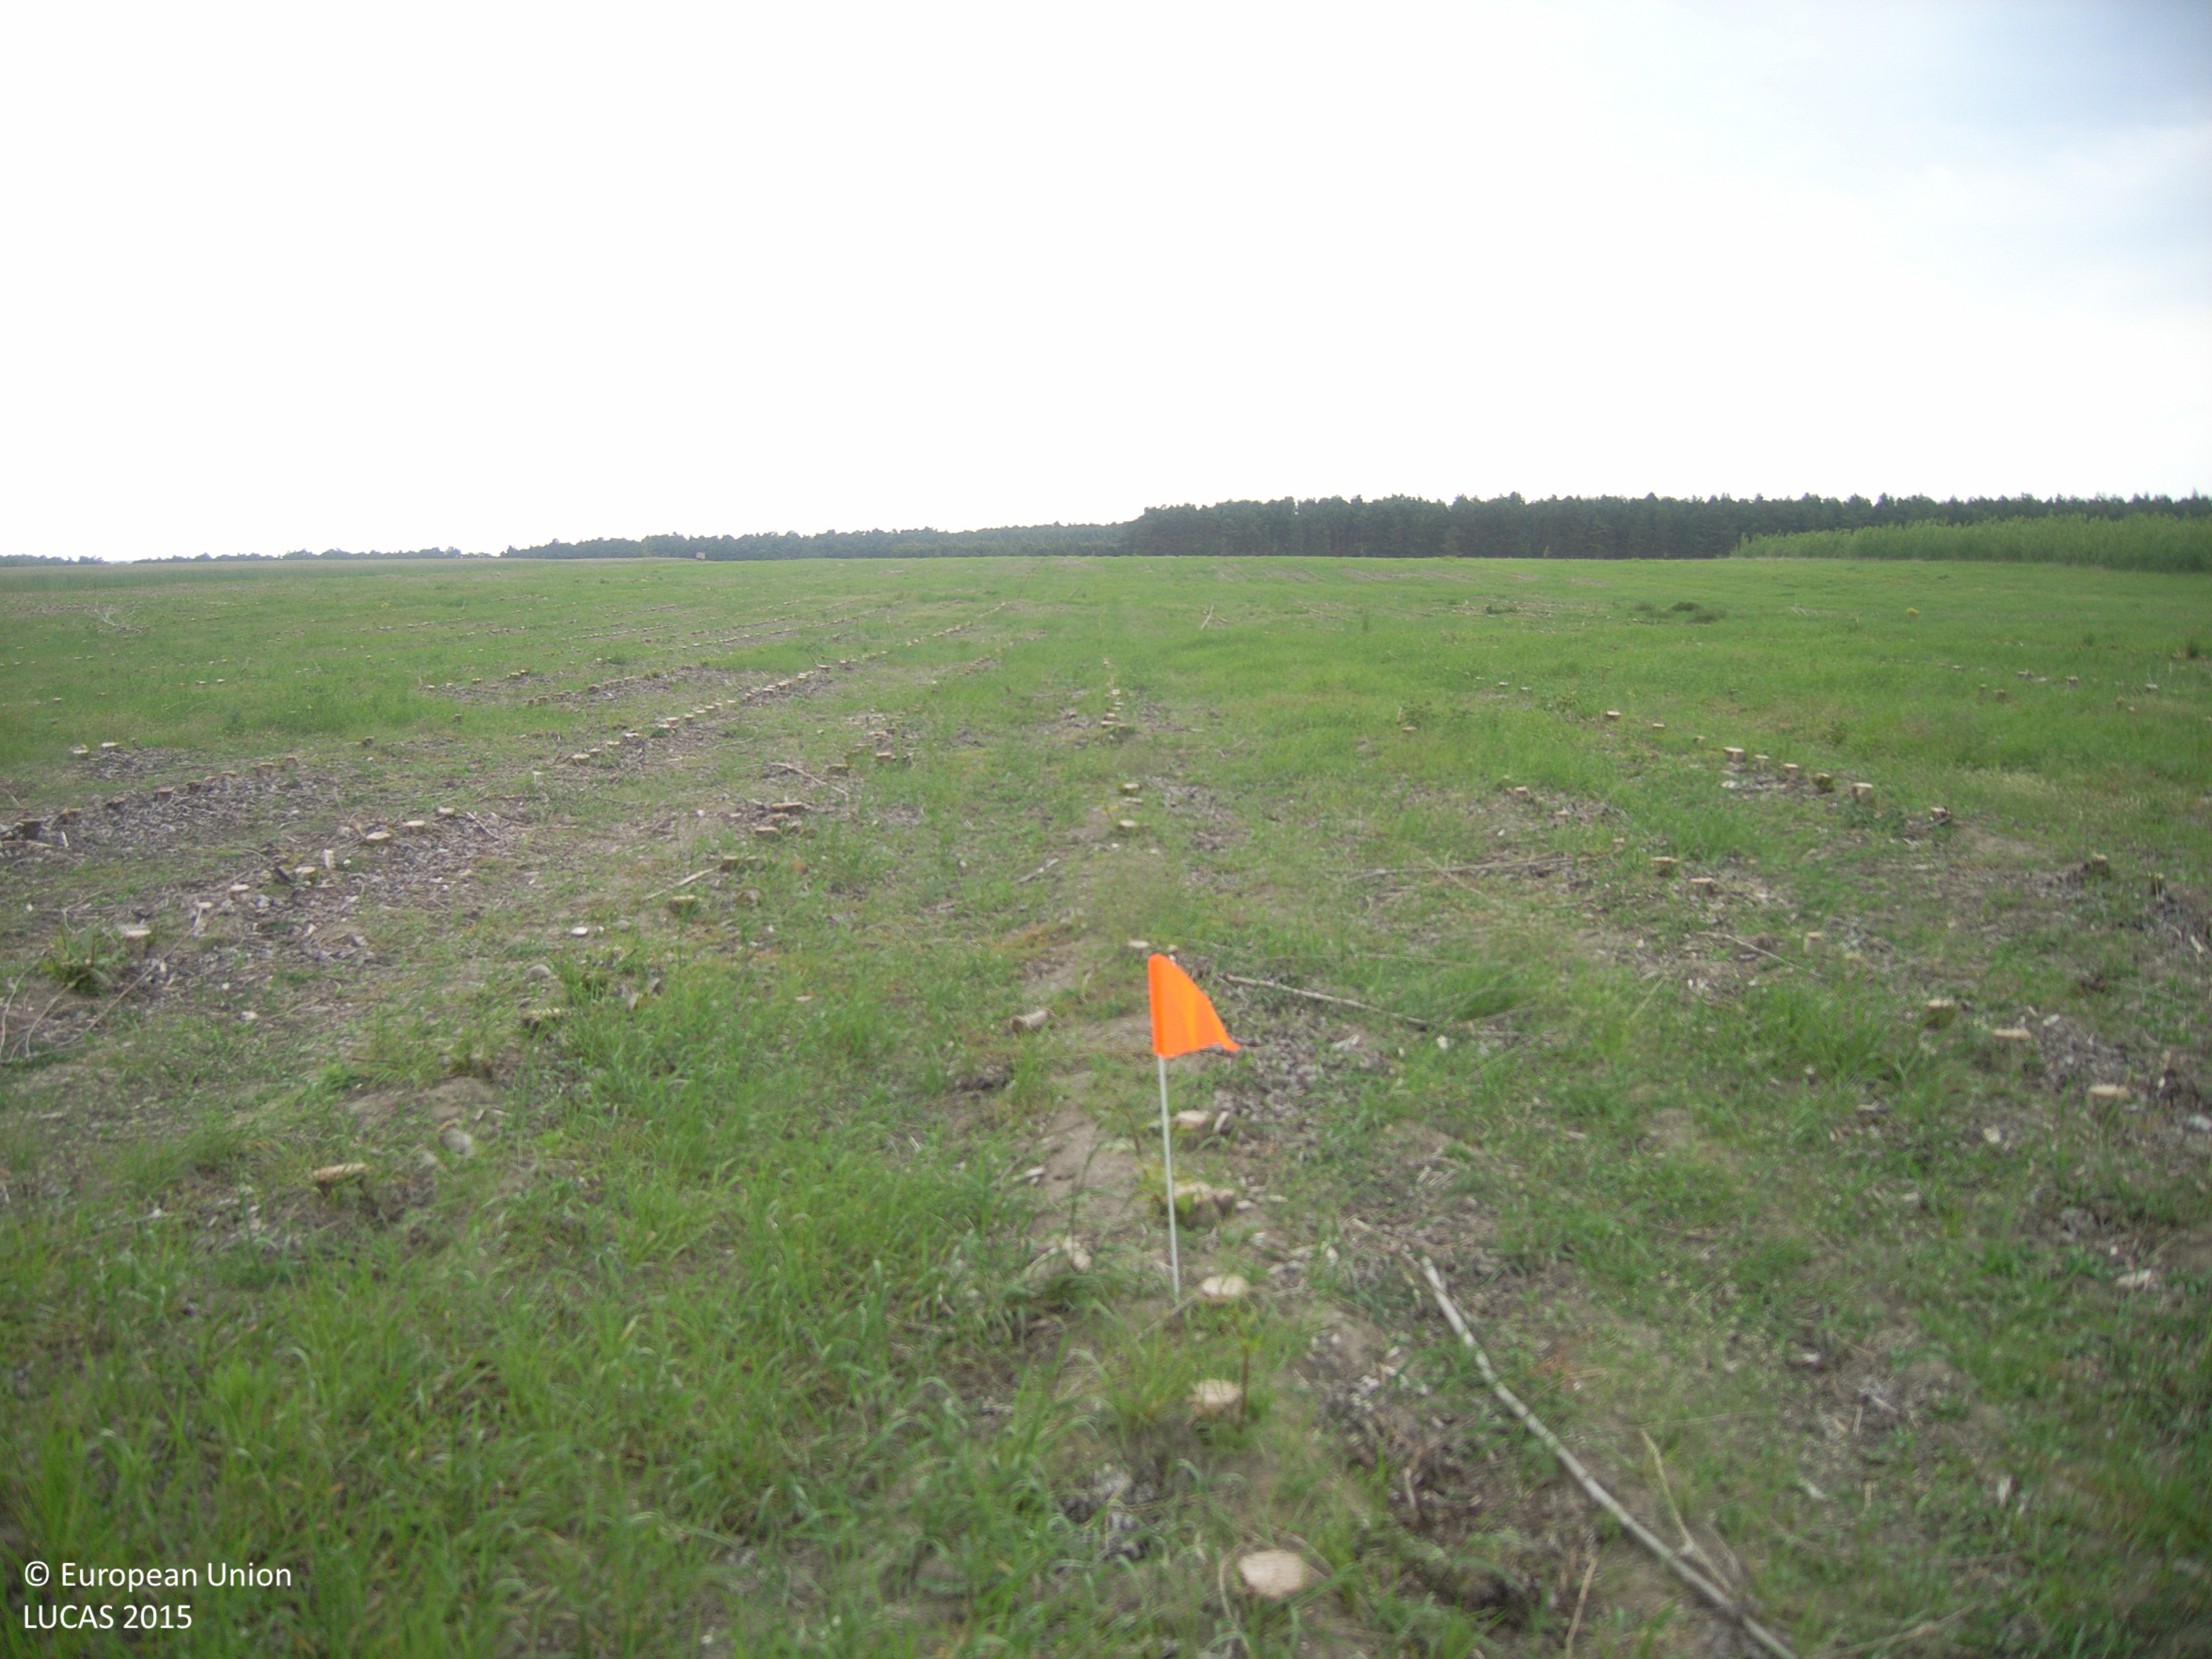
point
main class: Grassland
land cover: Grassland with sparse tree/shrub cover
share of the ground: > 75 %
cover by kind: herbaceous plants 90 %, broadleaved forest trees 5 %, shrubs 5 %
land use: Forestry
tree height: > 5 m
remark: Clear cut
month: May
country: DE
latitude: 52.1699
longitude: 14.4025
